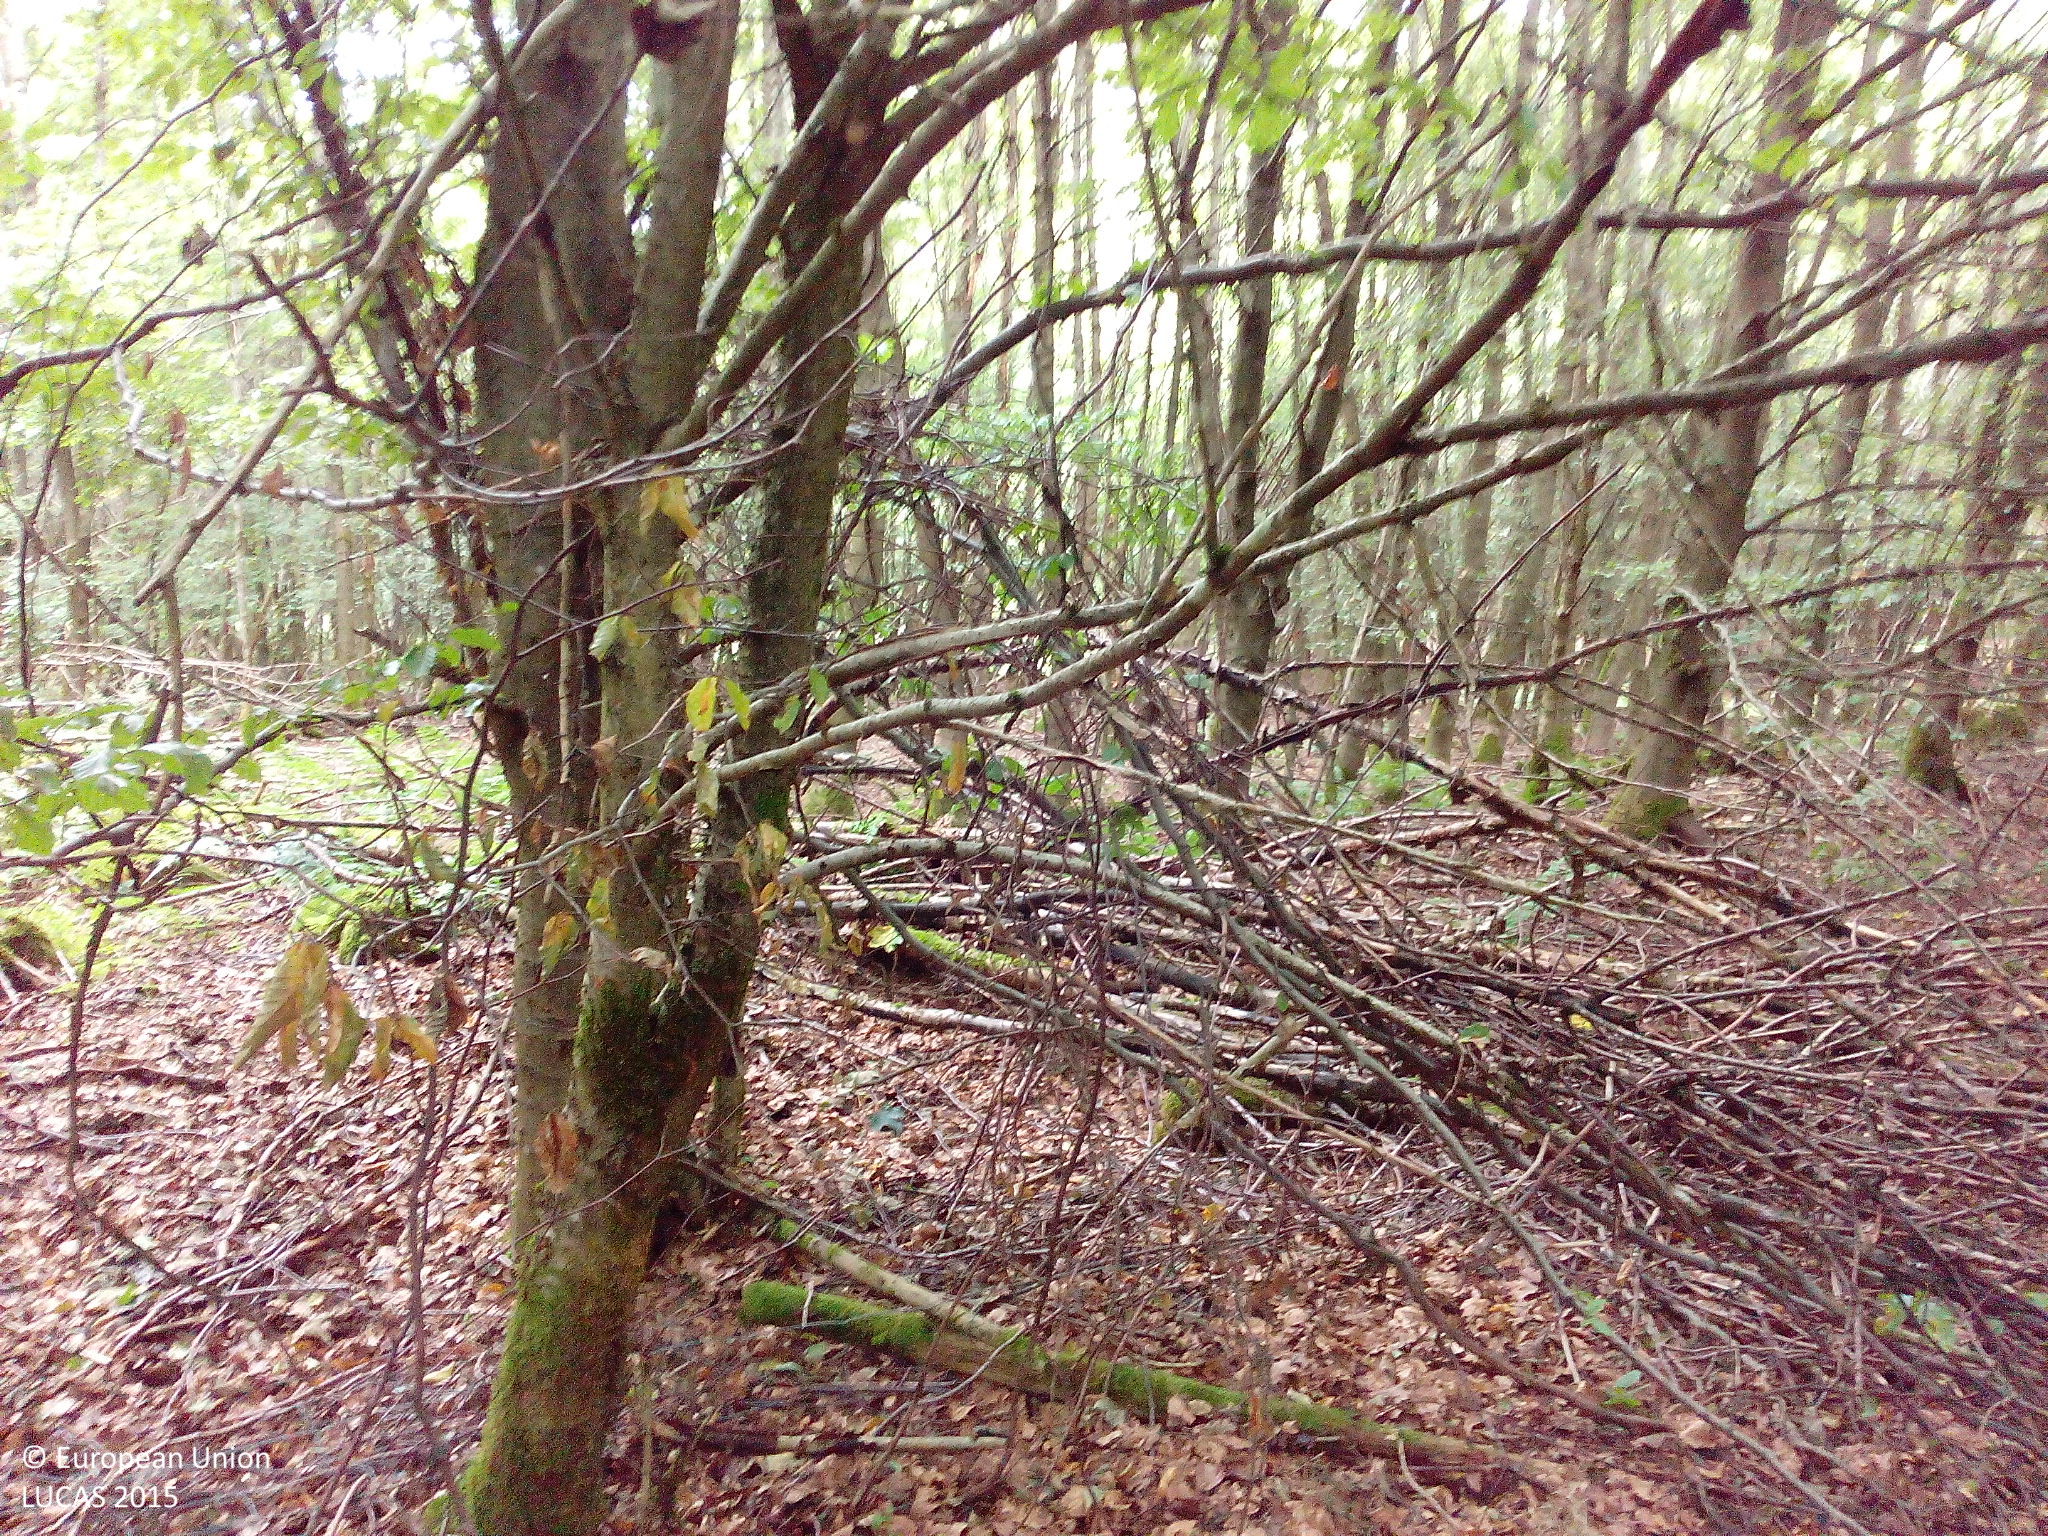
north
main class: Woodland
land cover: Broadleaved woodland
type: beech forest
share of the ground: > 75 %
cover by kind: broadleaved forest trees 95 %, unconsolidated bare surface 5 %
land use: Forestry
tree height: > 5 m
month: August
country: DE
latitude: 50.5954
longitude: 9.2515
